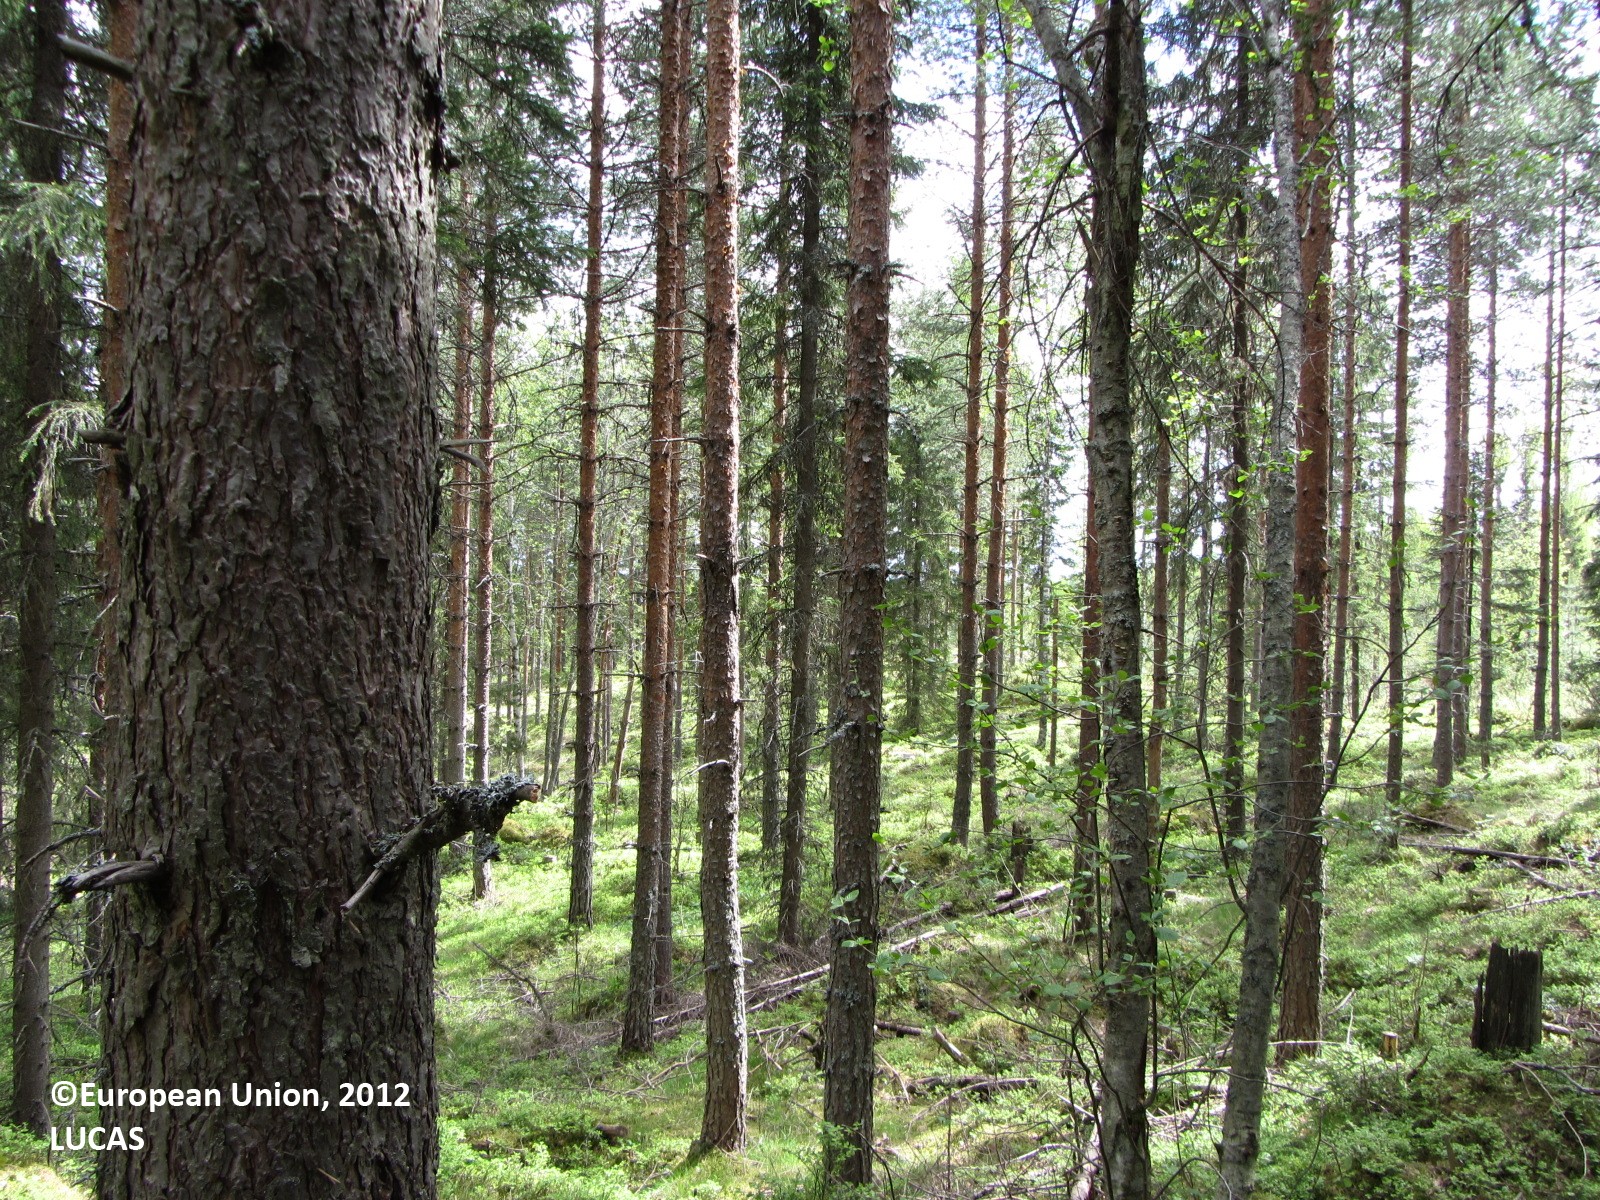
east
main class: Woodland
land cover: Pine dominated coniferous woodland
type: boreal forest
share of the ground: > 75 %
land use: Forestry
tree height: > 5 m
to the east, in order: Pine dominated coniferous woodland; Grassland with sparse tree/shrub cover; Pine dominated mixed woodland; Pine dominated coniferous woodland; Spruce dominated mixed woodland; Shrubland with sparse tree cover; Spruce dominated mixed woodland
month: May
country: FI
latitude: 62.4636
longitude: 25.5270
